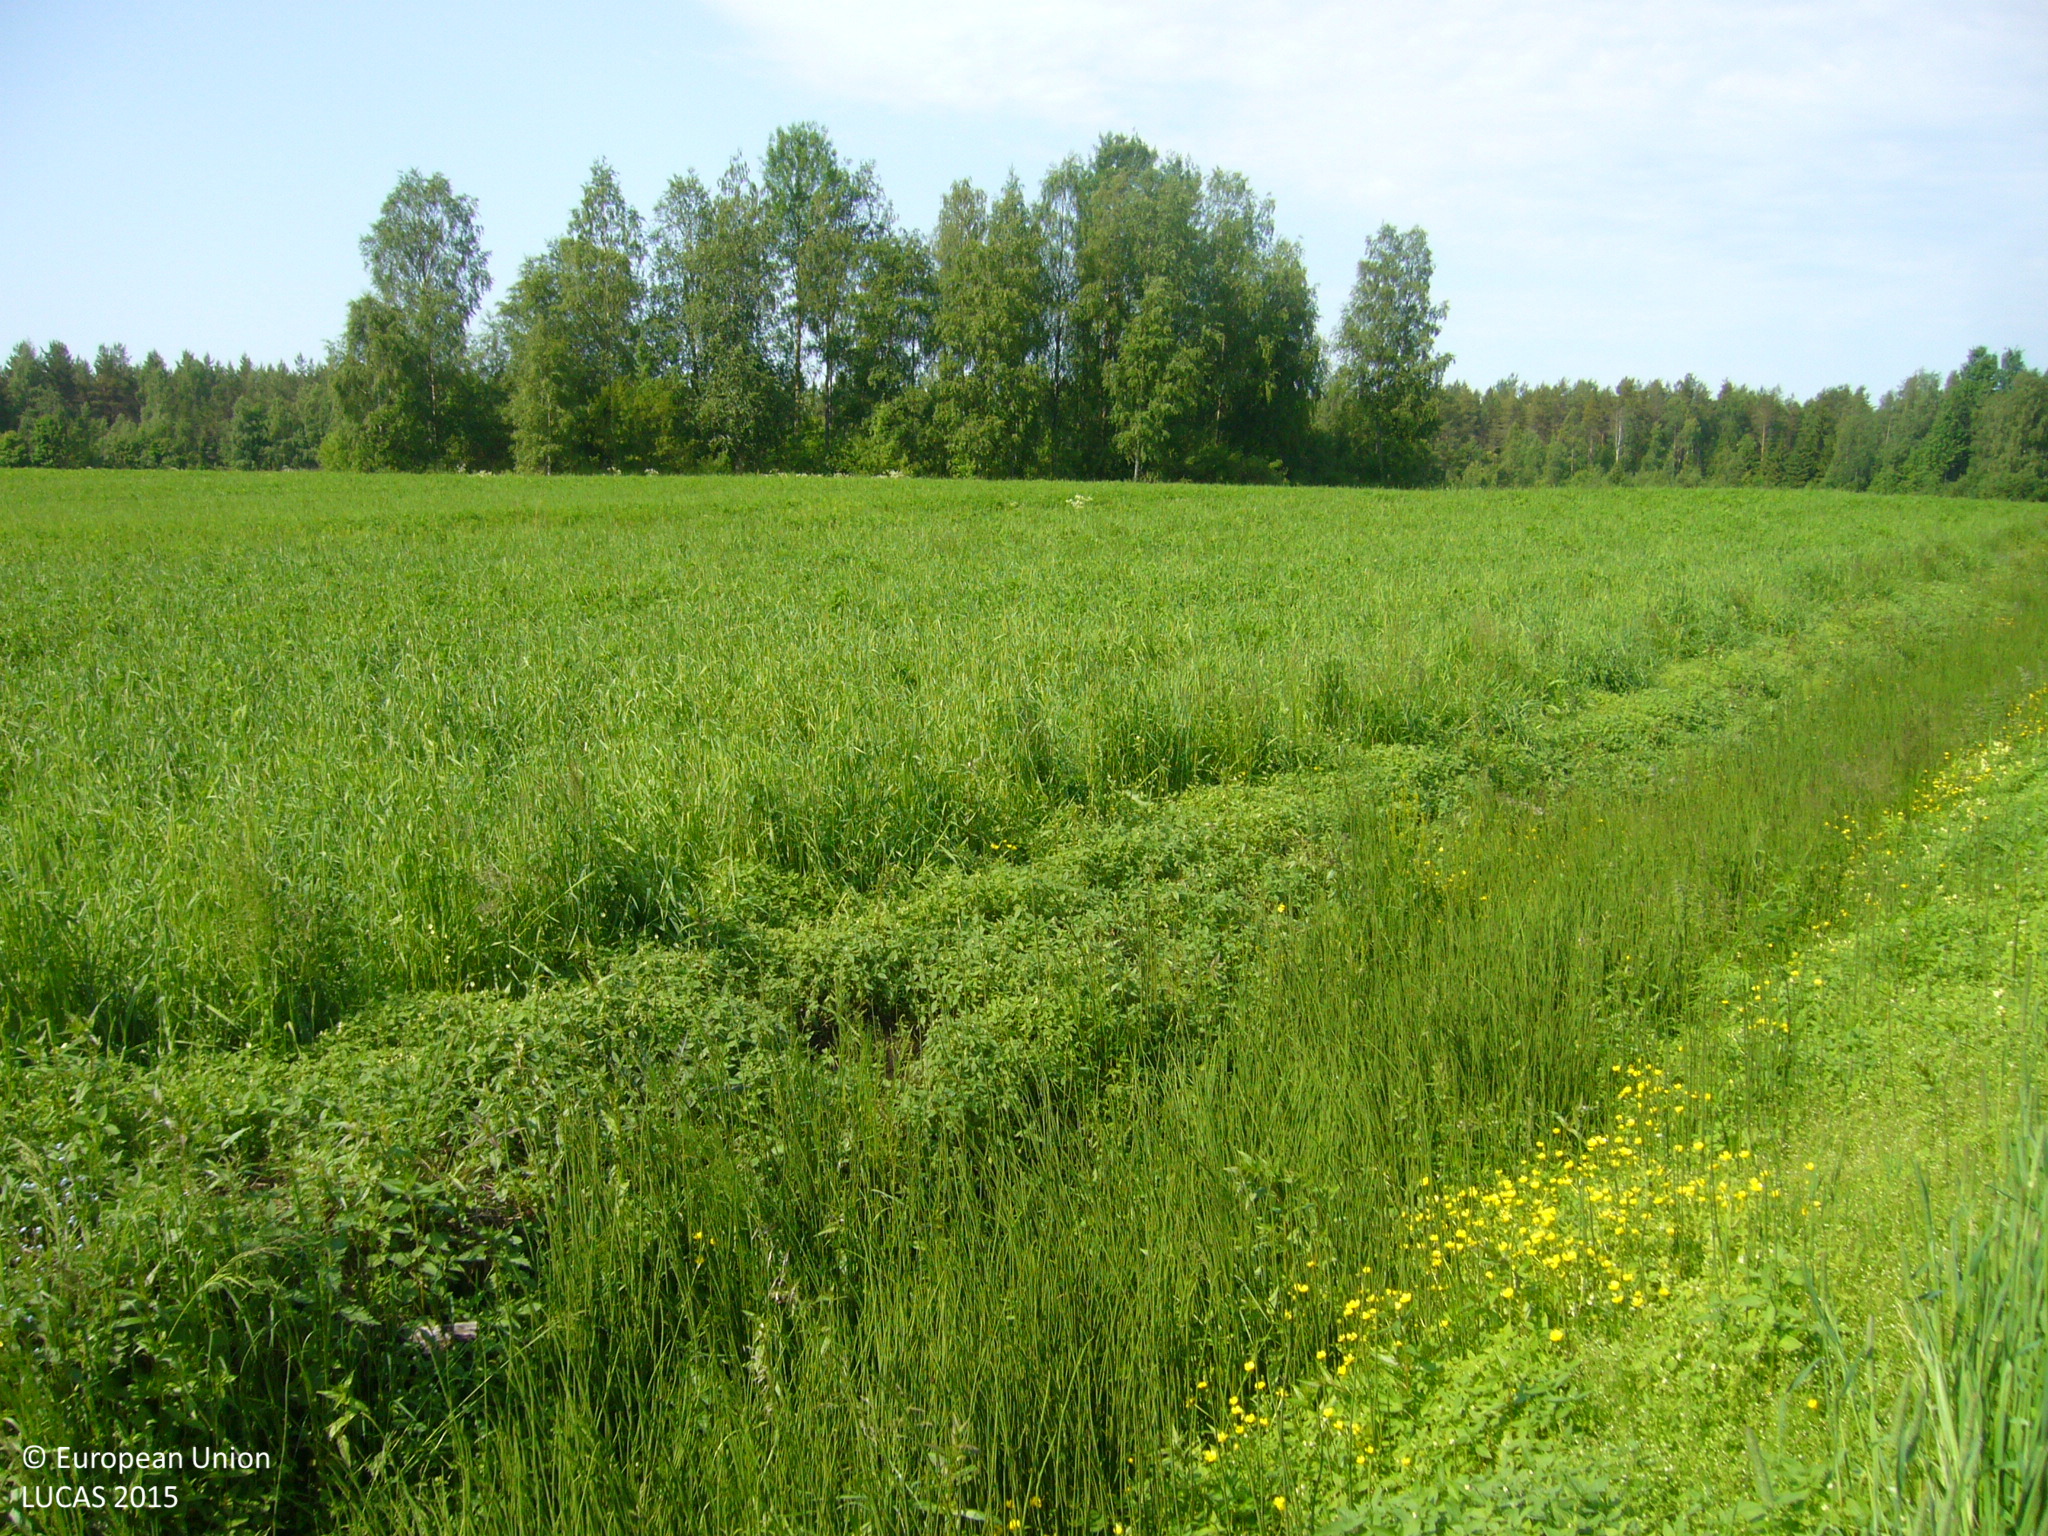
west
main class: Cropland
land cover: Temporary grasslands
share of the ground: > 75 %
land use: Agriculture (excluding fallow land and kitchen gardens)
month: July
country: FI
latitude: 63.6640
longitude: 25.8880
